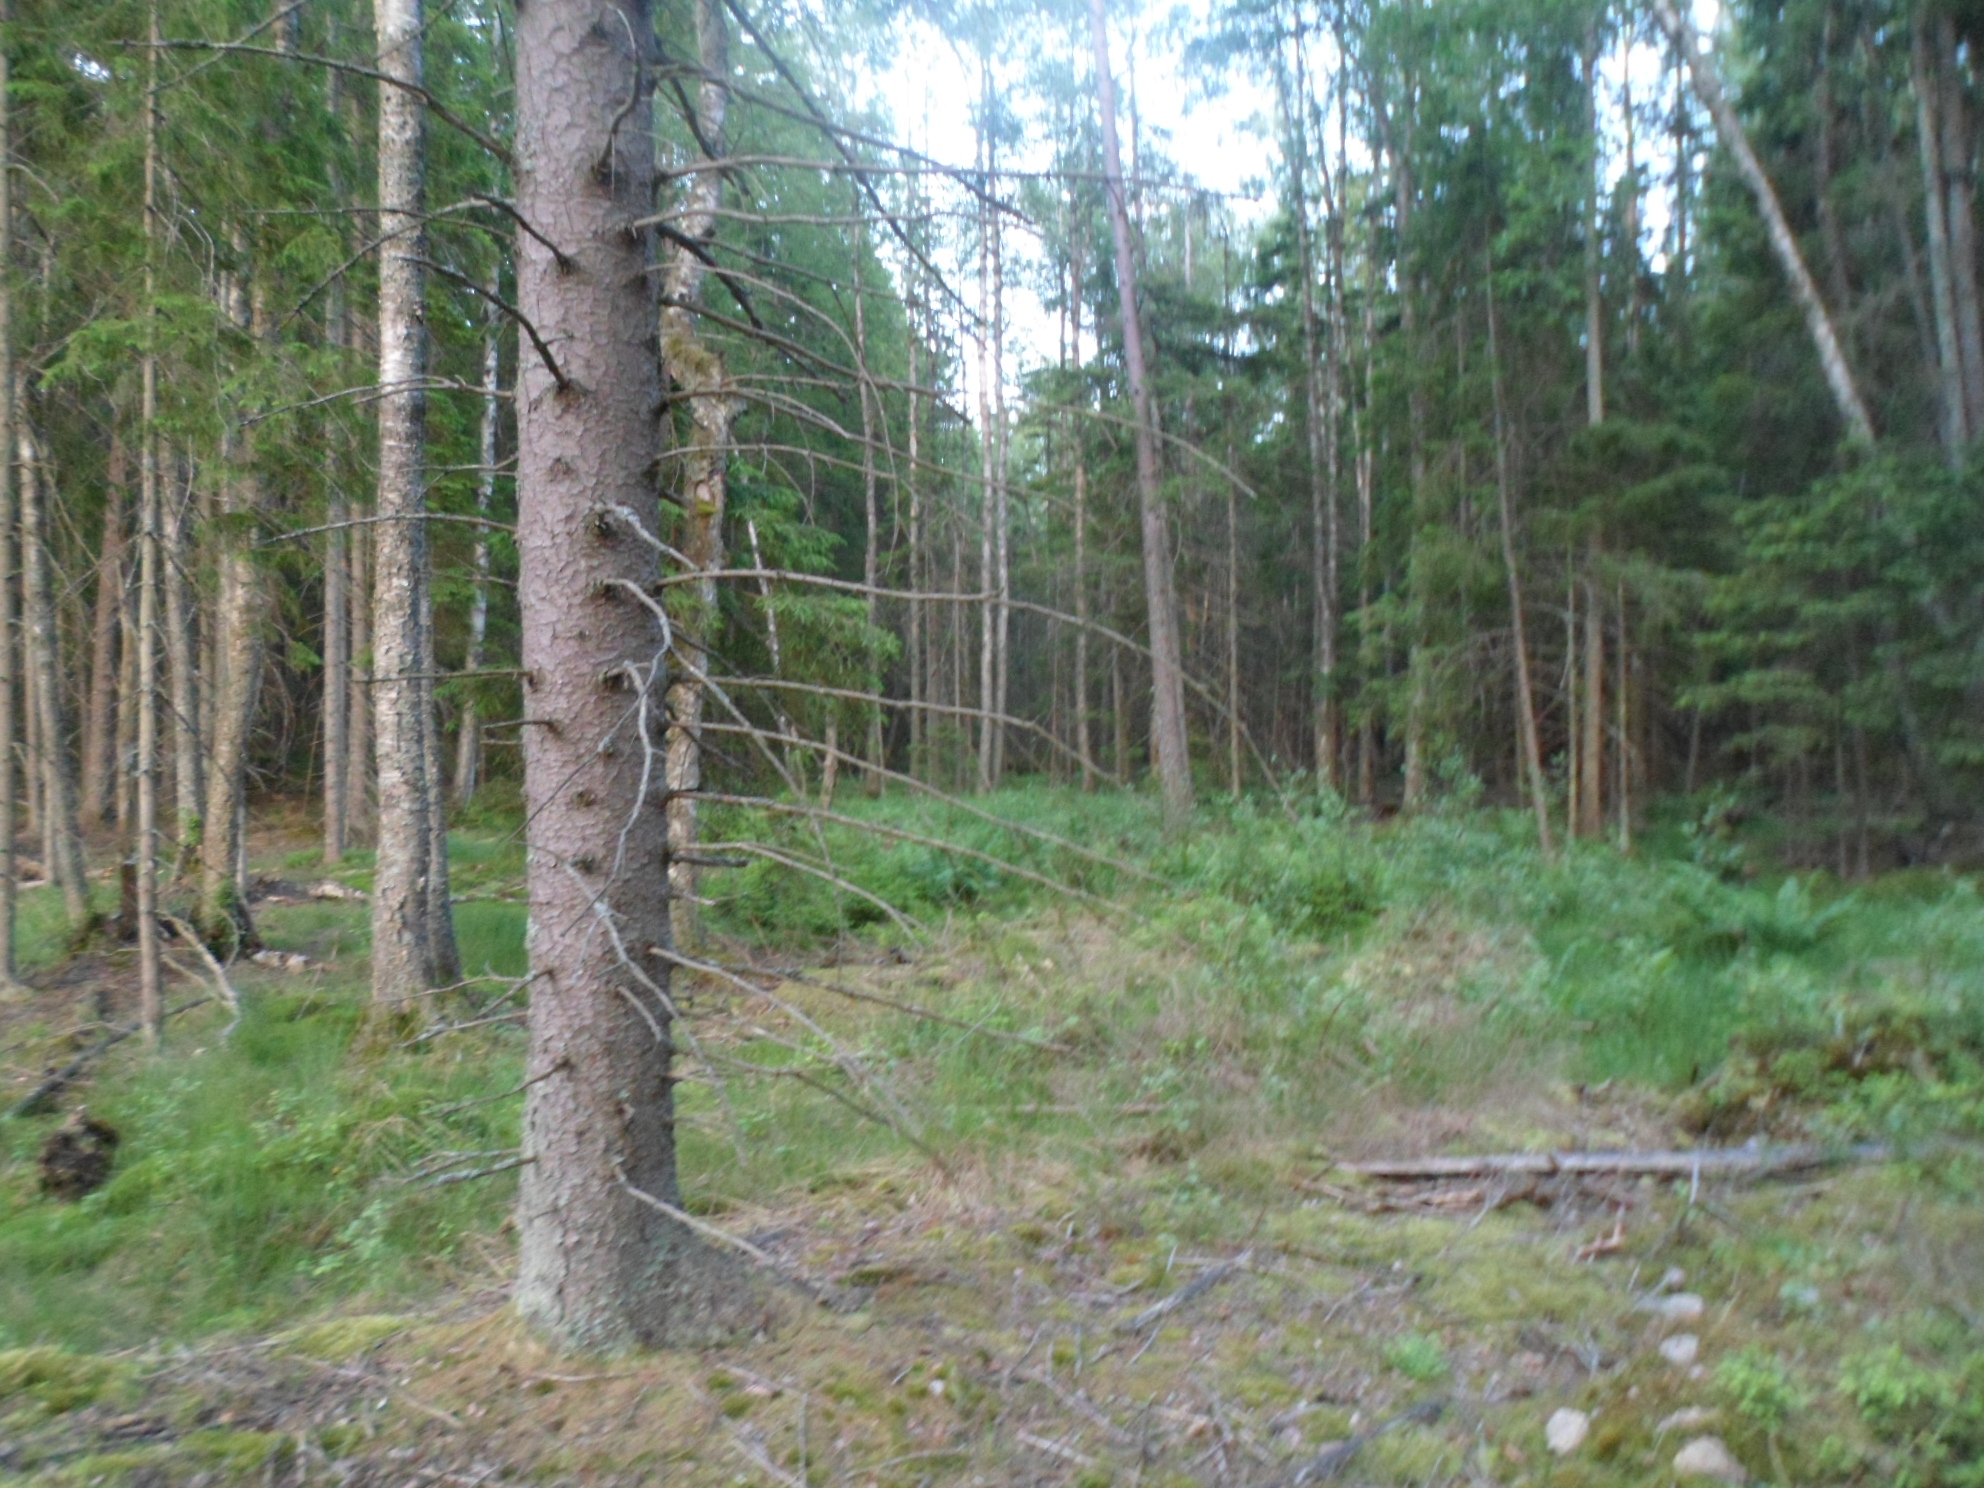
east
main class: Woodland
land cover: Spruce dominated coniferous woodland
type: boreal forest
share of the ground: 50 - 75 %
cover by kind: coniferous forest trees 55 %, shrubs 15 %, lichens and mosses 15 %, broadleaved forest trees 10 %, herbaceous plants 5 %
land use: Forestry
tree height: > 5 m
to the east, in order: Spruce dominated coniferous woodland; Rivers and streams; Spruce dominated mixed woodland; Spruce dominated coniferous woodland; Ditches and canals; Spruce dominated coniferous woodland; Grassland with sparse tree/shrub cover; Spruce dominated mixed woodland
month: June
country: SE
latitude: 57.0479
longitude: 15.3879
